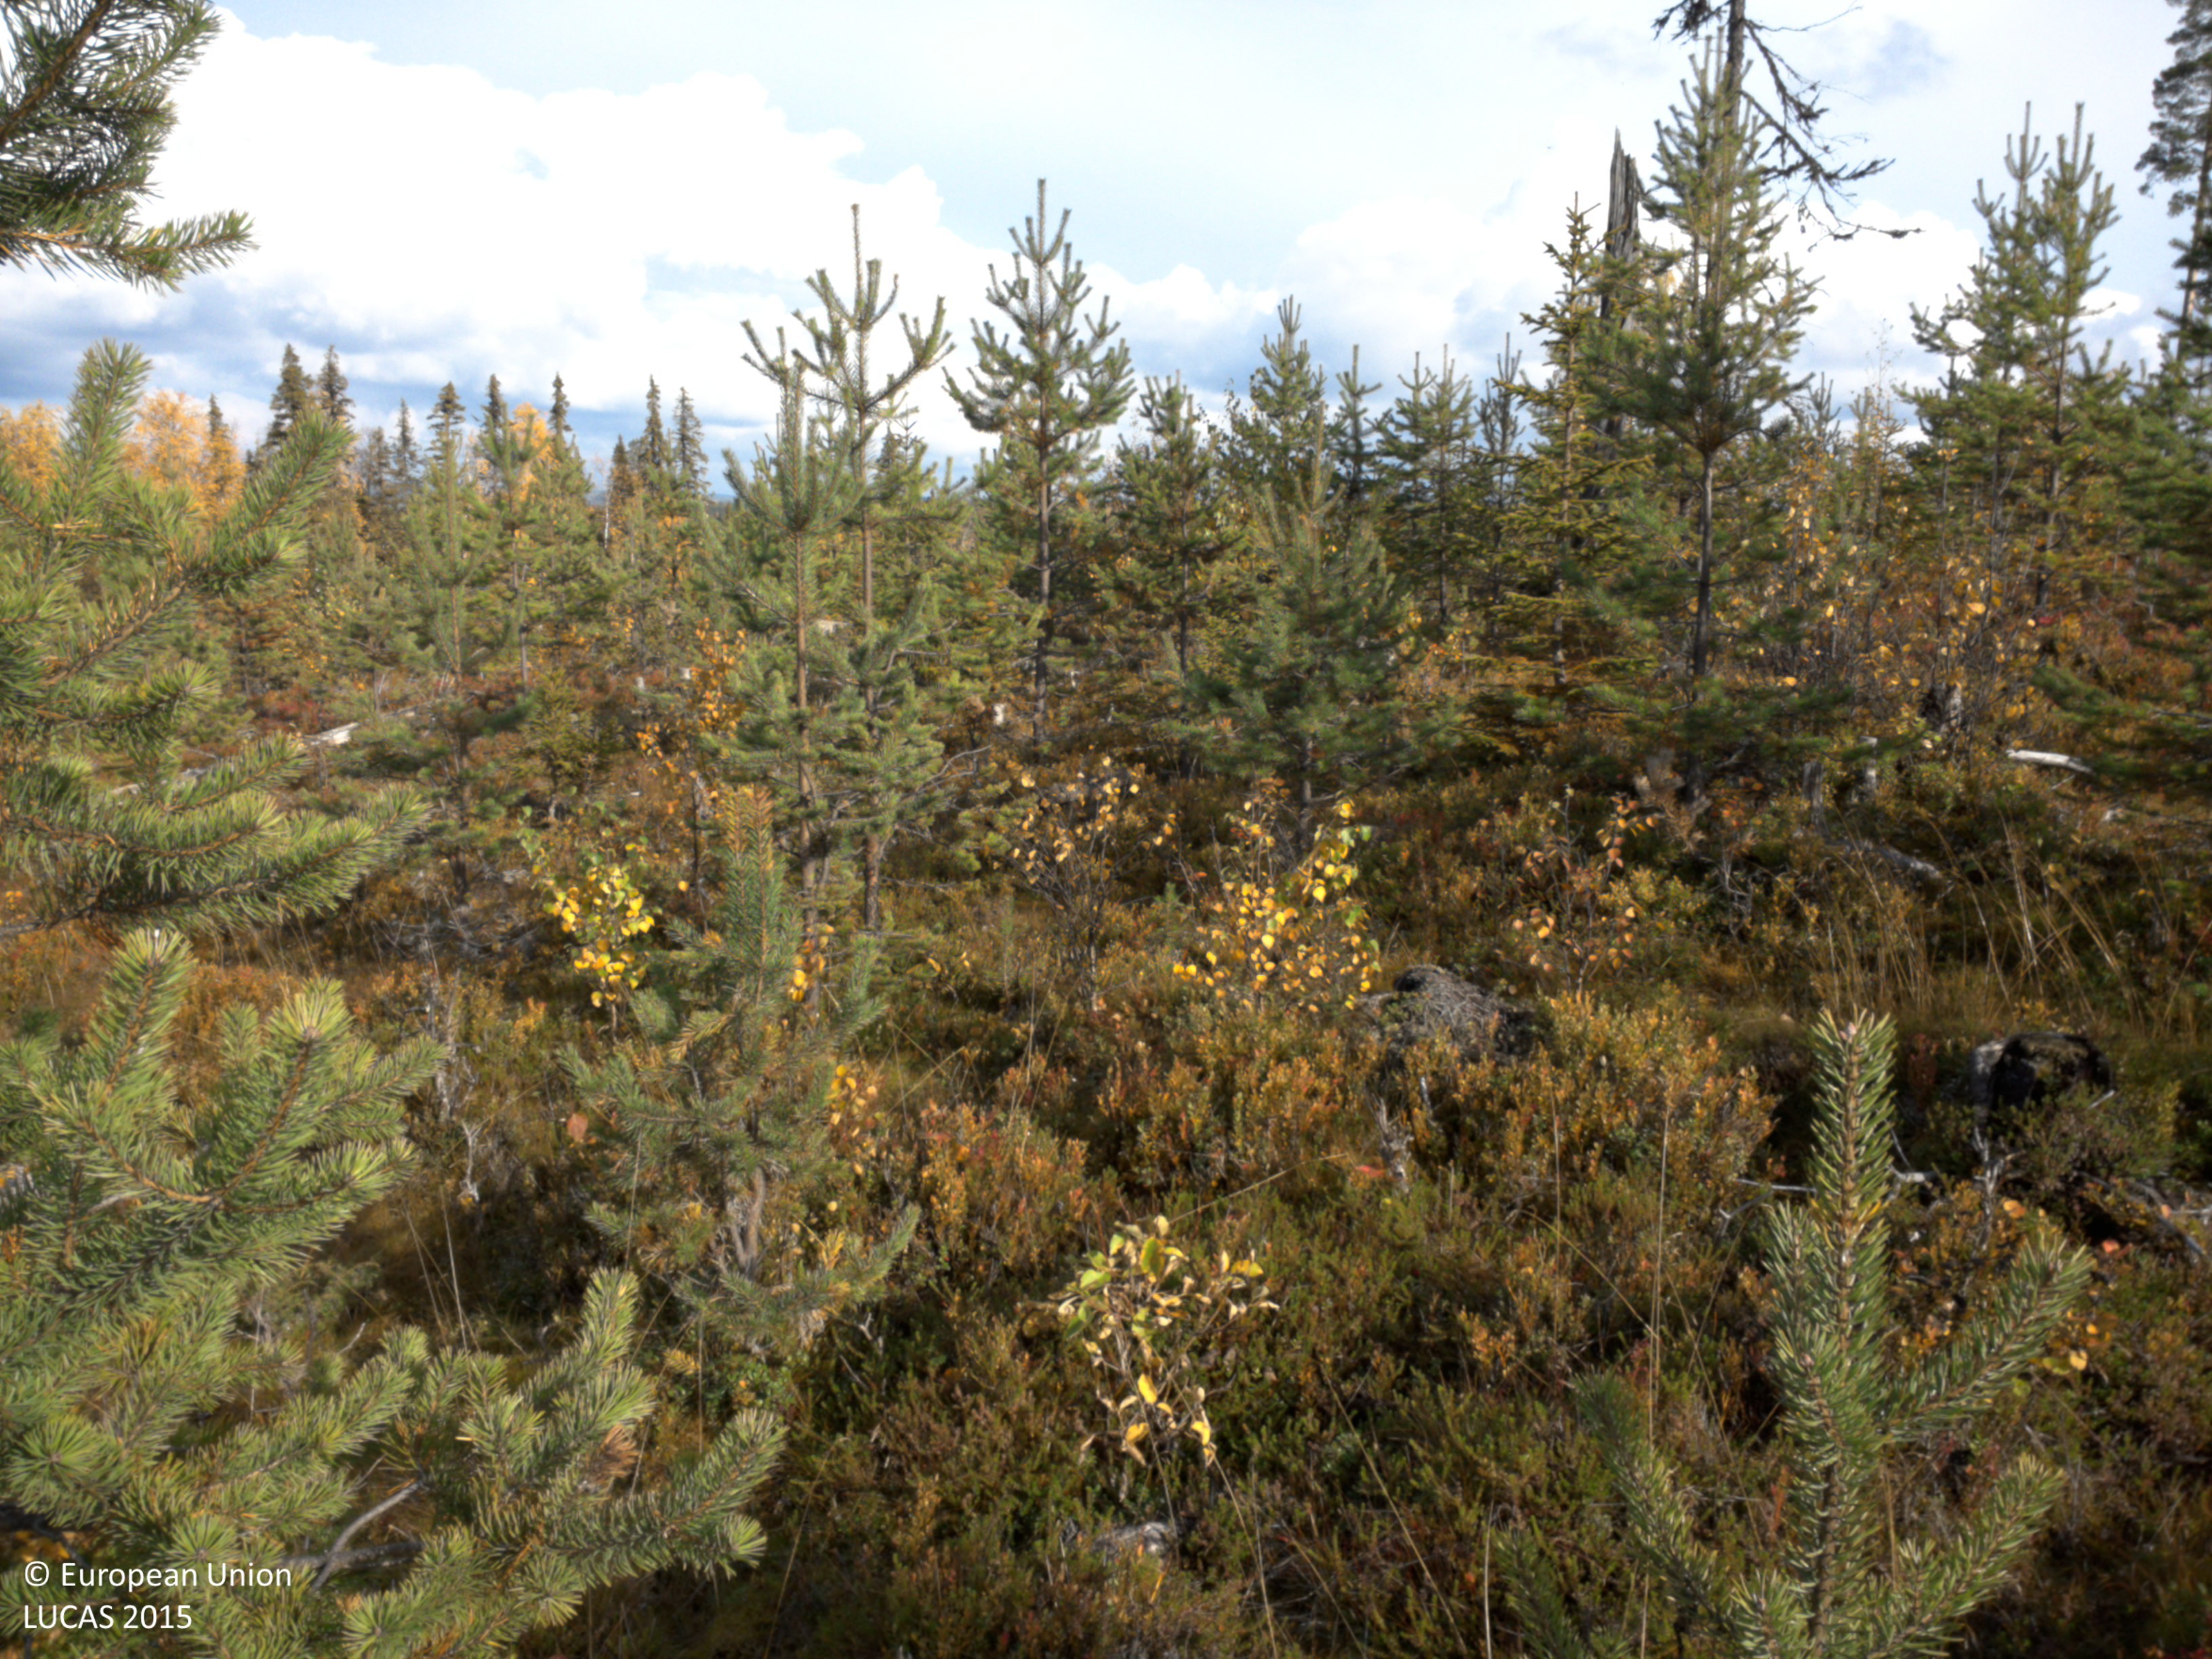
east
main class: Woodland
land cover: Other mixed woodland
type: boreal forest
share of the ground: 50 - 75 %
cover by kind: coniferous forest trees 50 %, broadleaved forest trees 25 %, shrubs 15 %, herbaceous plants 5 %, lichens and mosses 5 %
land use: Forestry
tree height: < 5 m
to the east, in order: Other mixed woodland; Pine dominated coniferous woodland; Pine dominated mixed woodland; Pine dominated coniferous woodland
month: September
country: SE
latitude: 64.7728
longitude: 19.1151
